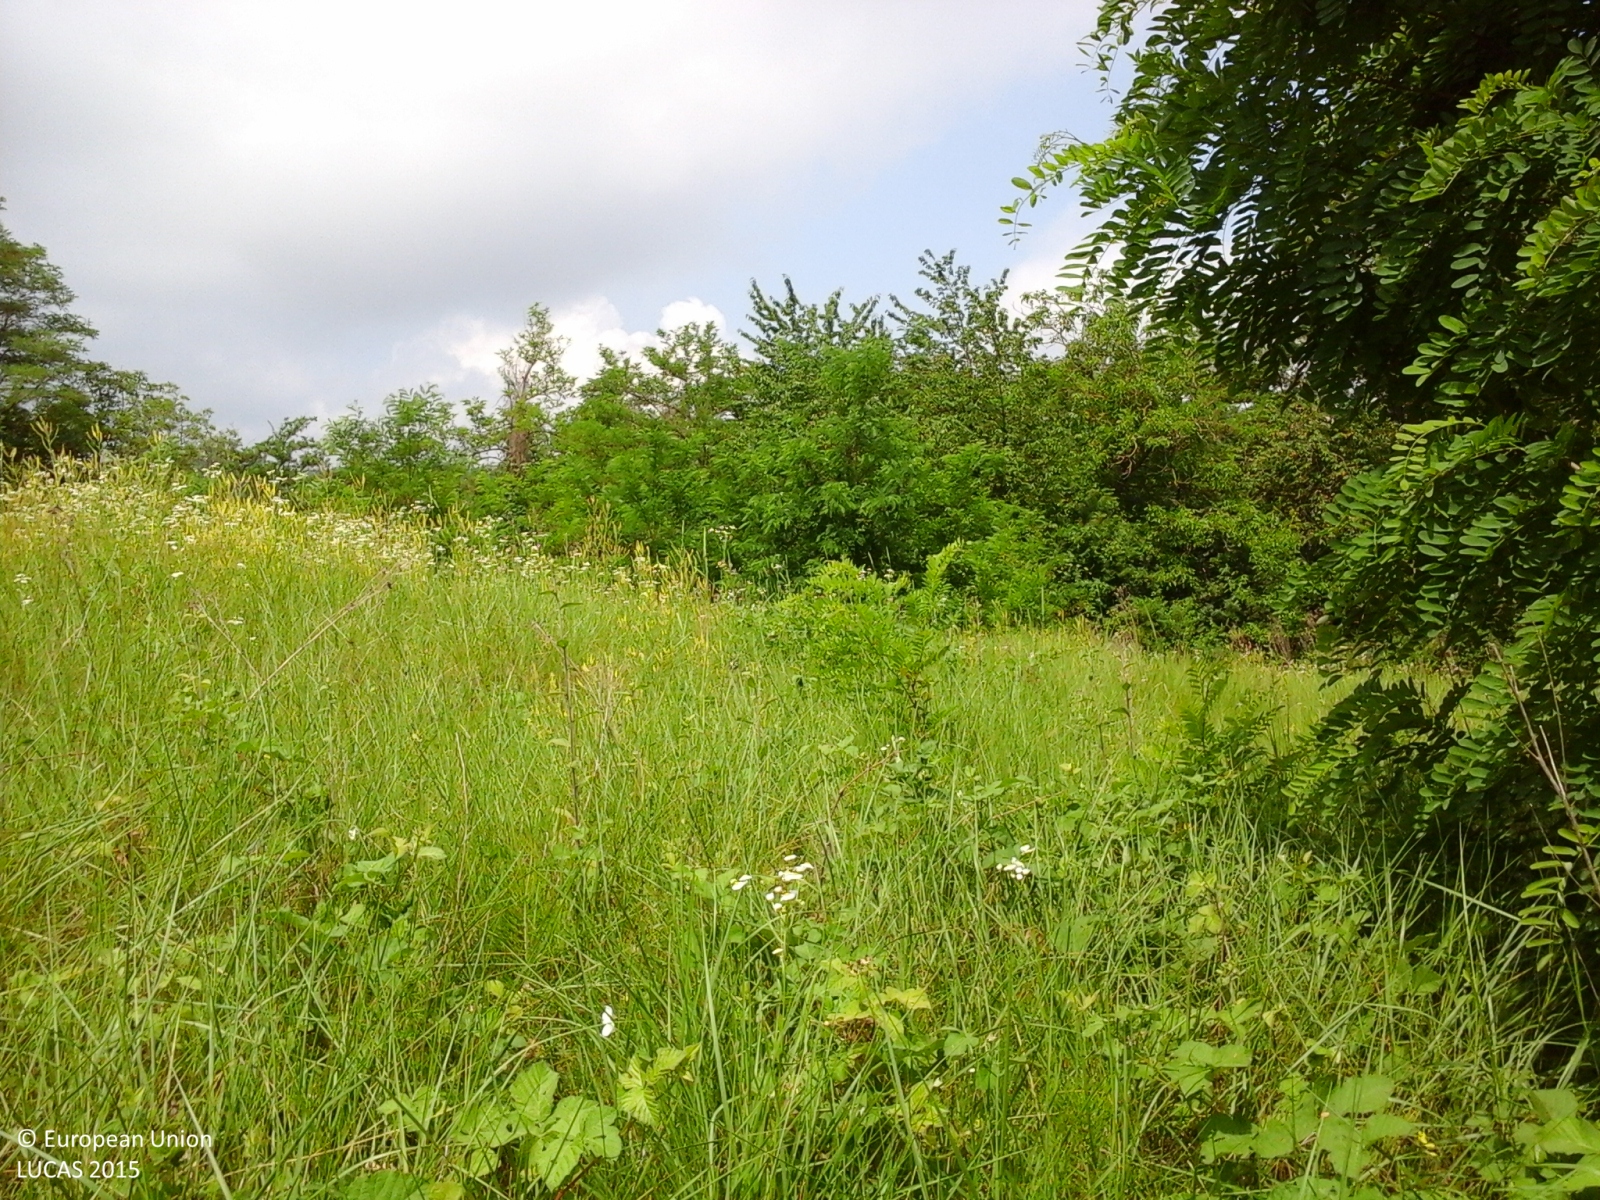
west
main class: Shrubland
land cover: Shrubland with sparse tree cover
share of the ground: > 75 %
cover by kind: shrubs 95 %, broadleaved forest trees 5 %
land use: Semi-natural and natural areas not in use
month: June
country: IT
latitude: 44.8550
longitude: 9.6843
